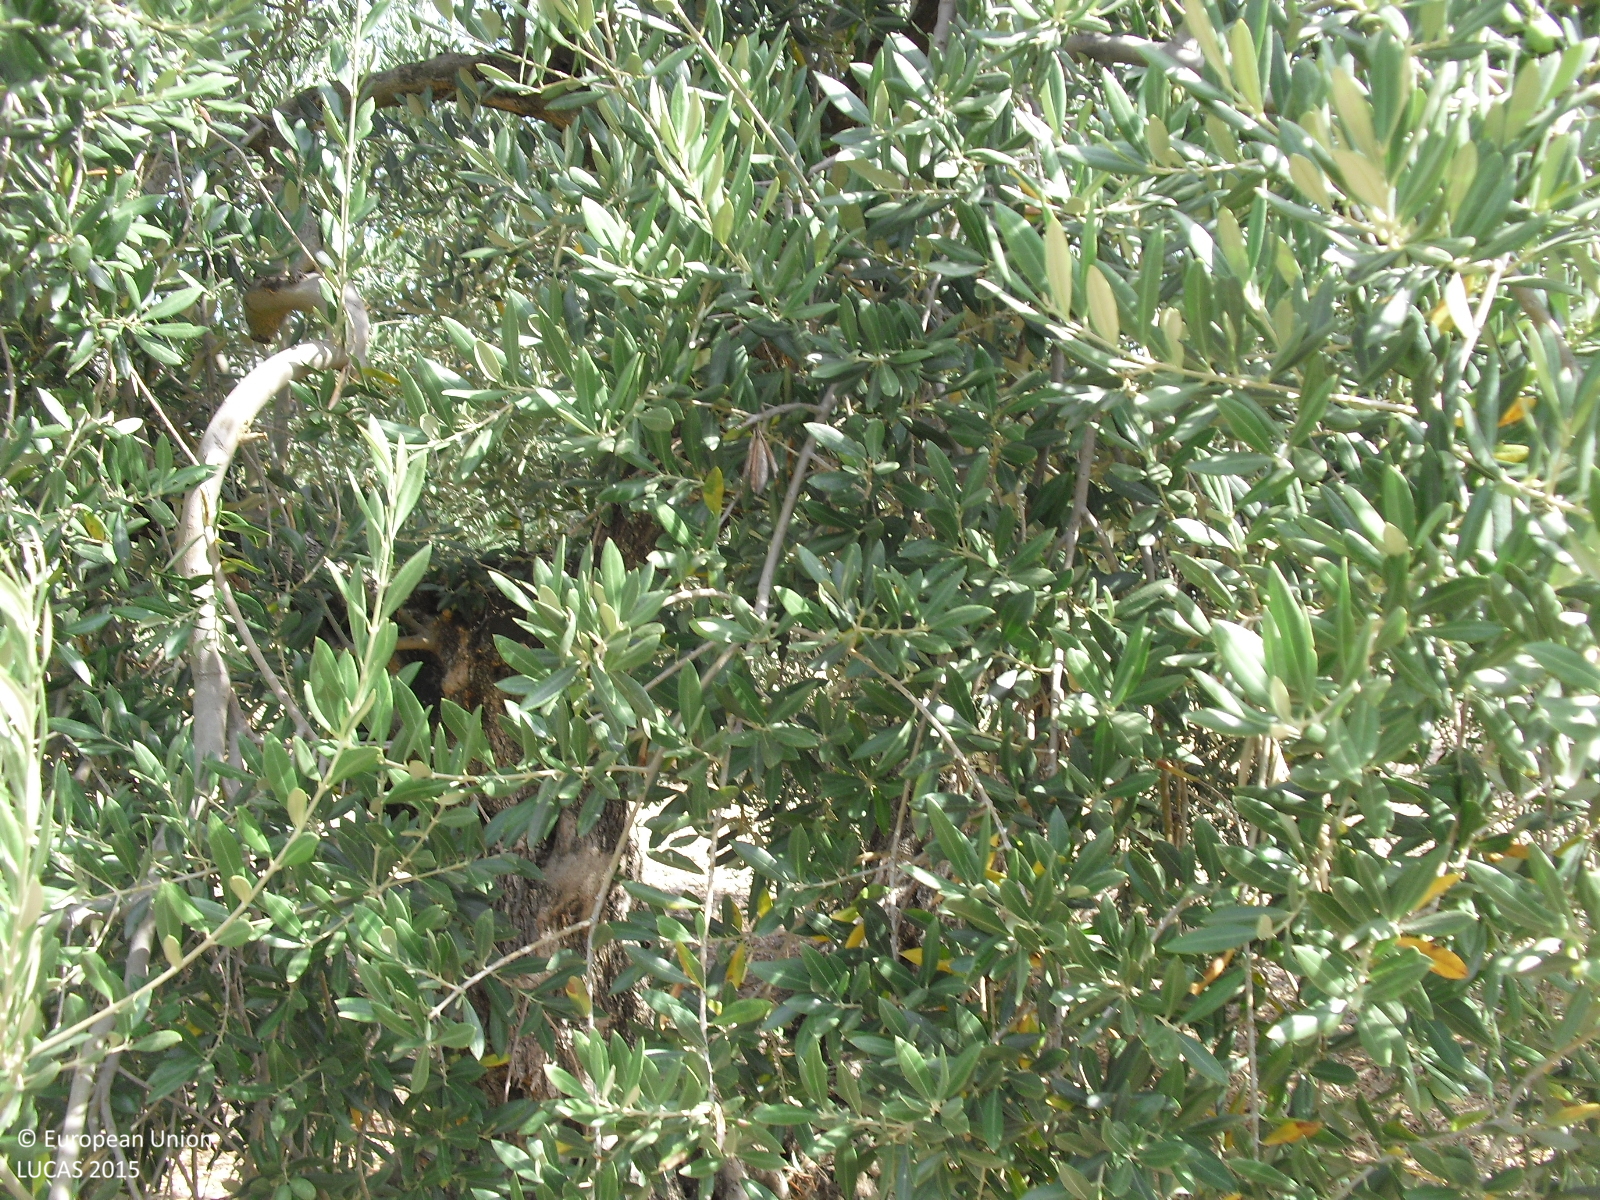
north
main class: Cropland
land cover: Olive groves
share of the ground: 25 - 50 %
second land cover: Other bare soil
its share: > 75 %
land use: Agriculture (excluding fallow land and kitchen gardens)
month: August
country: ES
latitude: 37.3721
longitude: -4.2158
